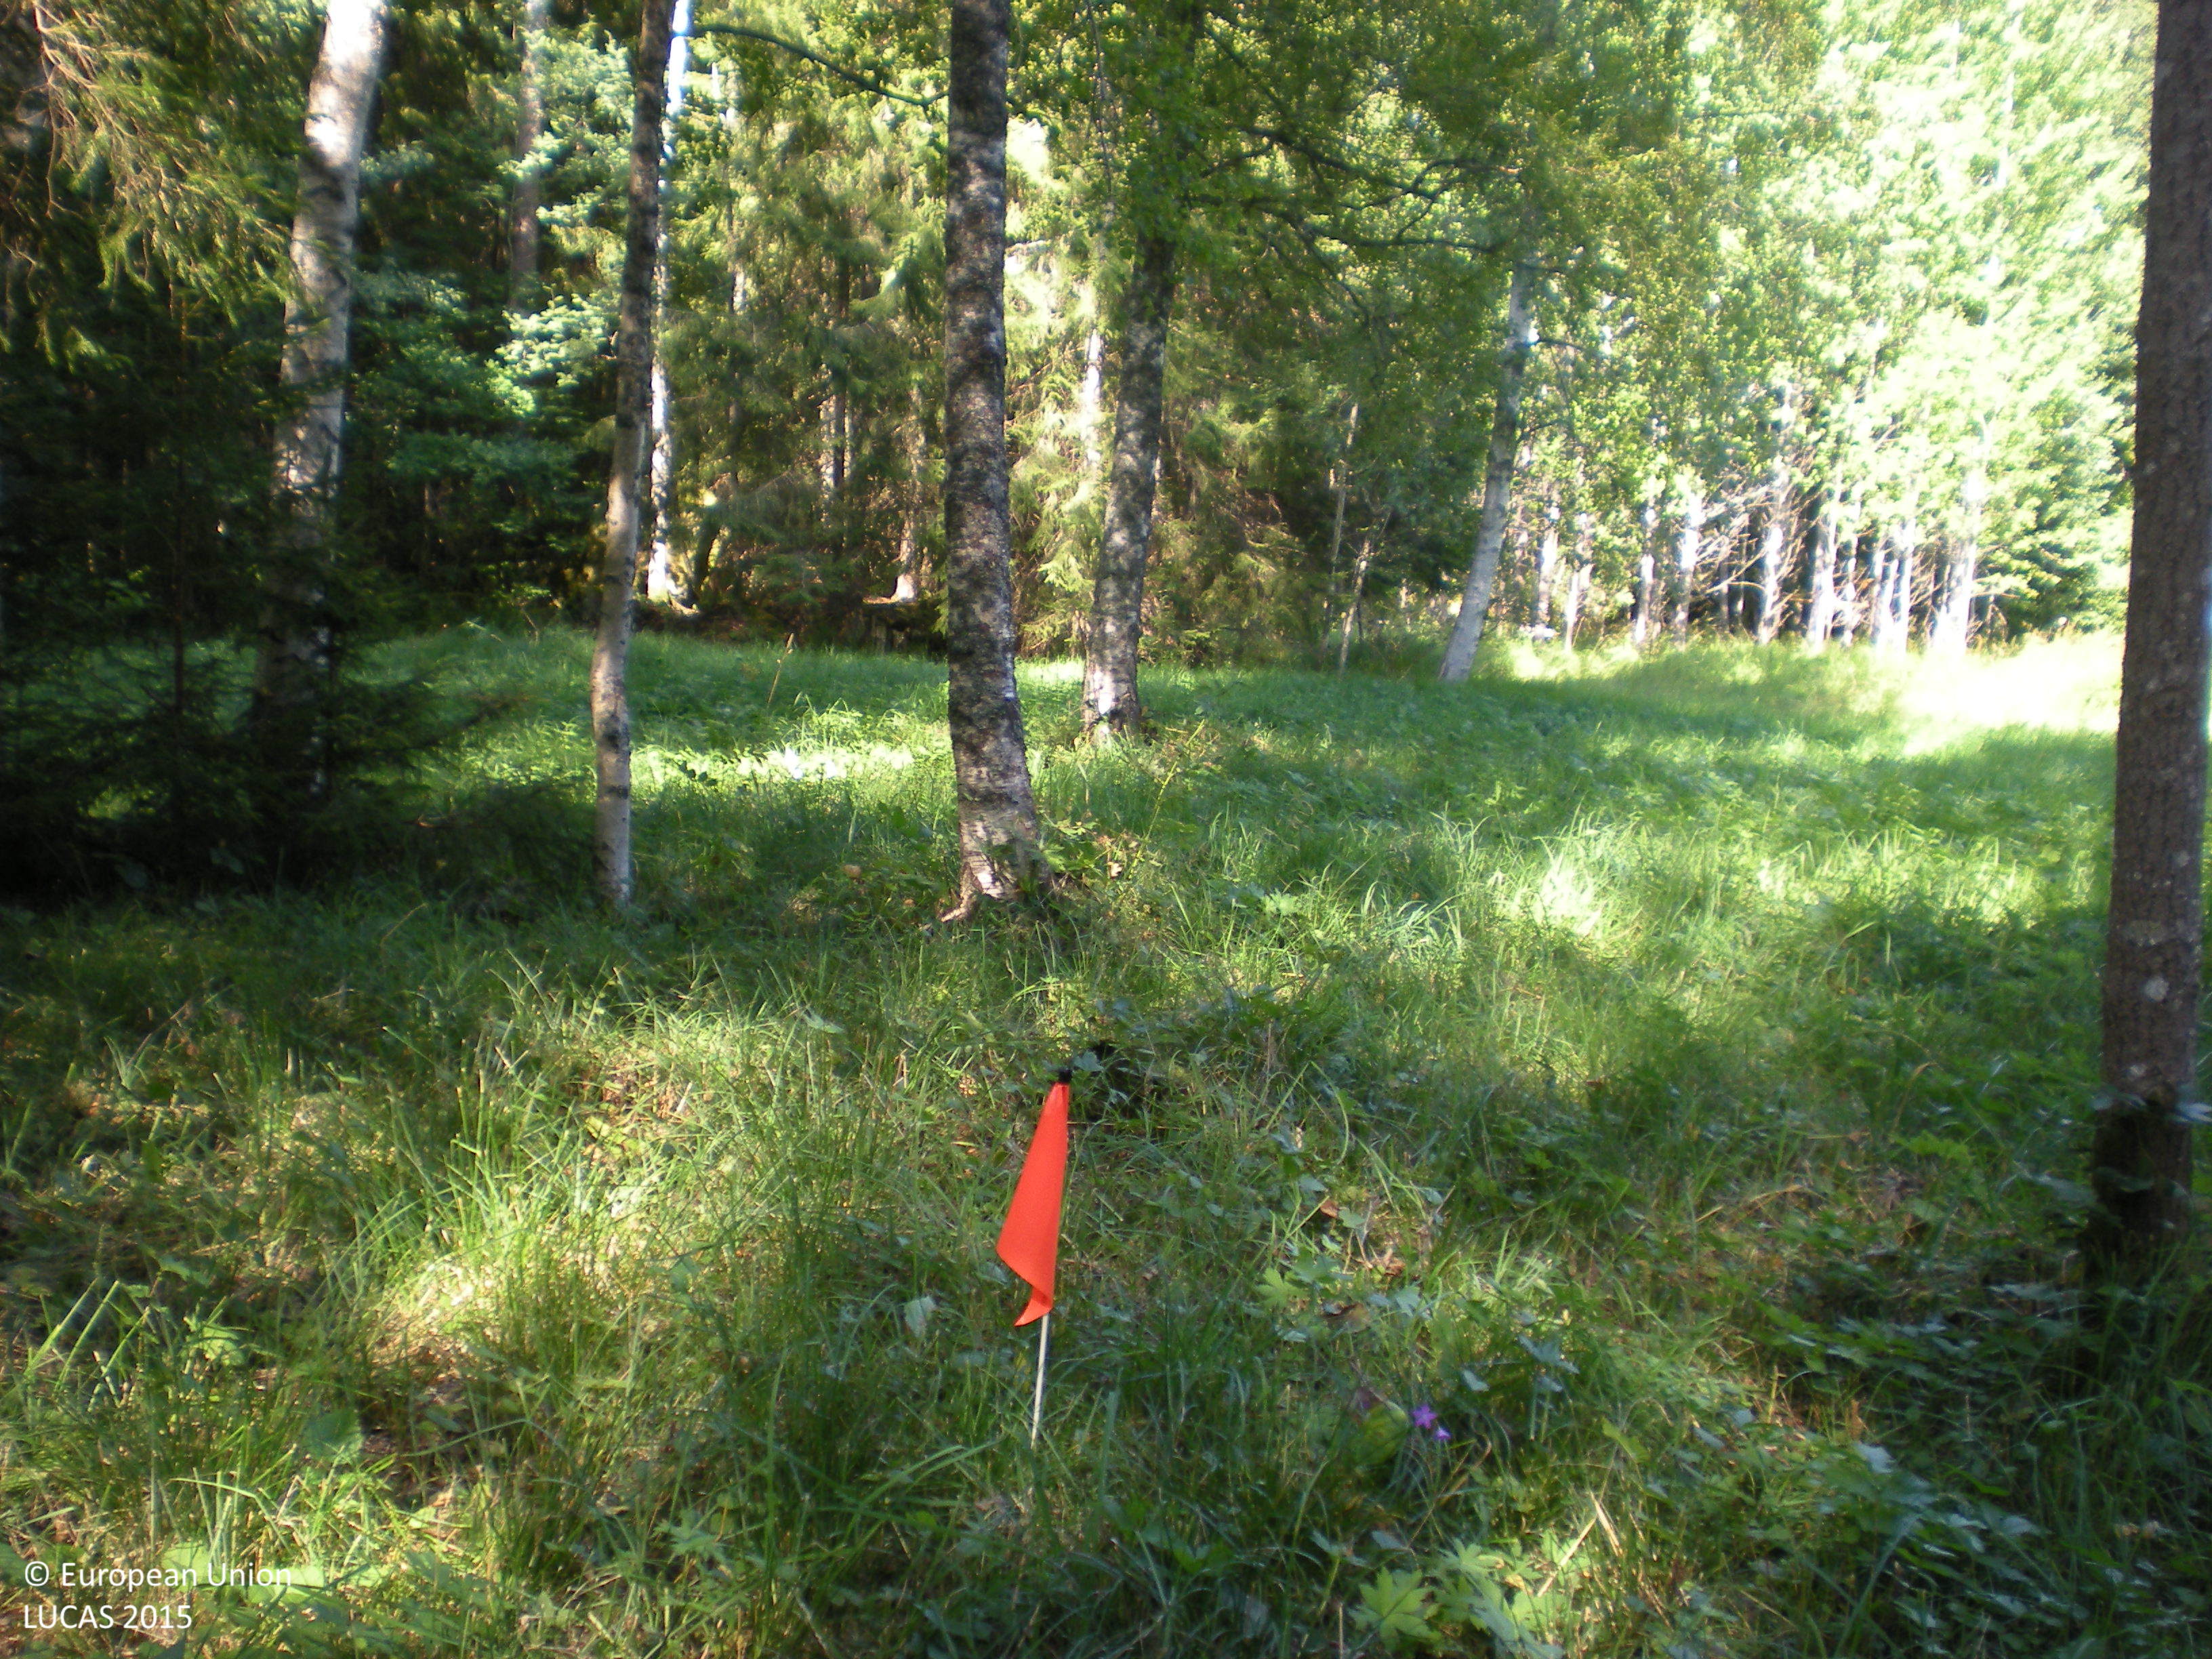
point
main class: Woodland
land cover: Broadleaved woodland
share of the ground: 25 - 50 %
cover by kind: broadleaved forest trees 40 %, herbaceous plants 40 %, coniferous forest trees 10 %, shrubs 5 %, lichens and mosses 5 %
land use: Forestry
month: August
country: SE
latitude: 60.6201
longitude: 17.3906
